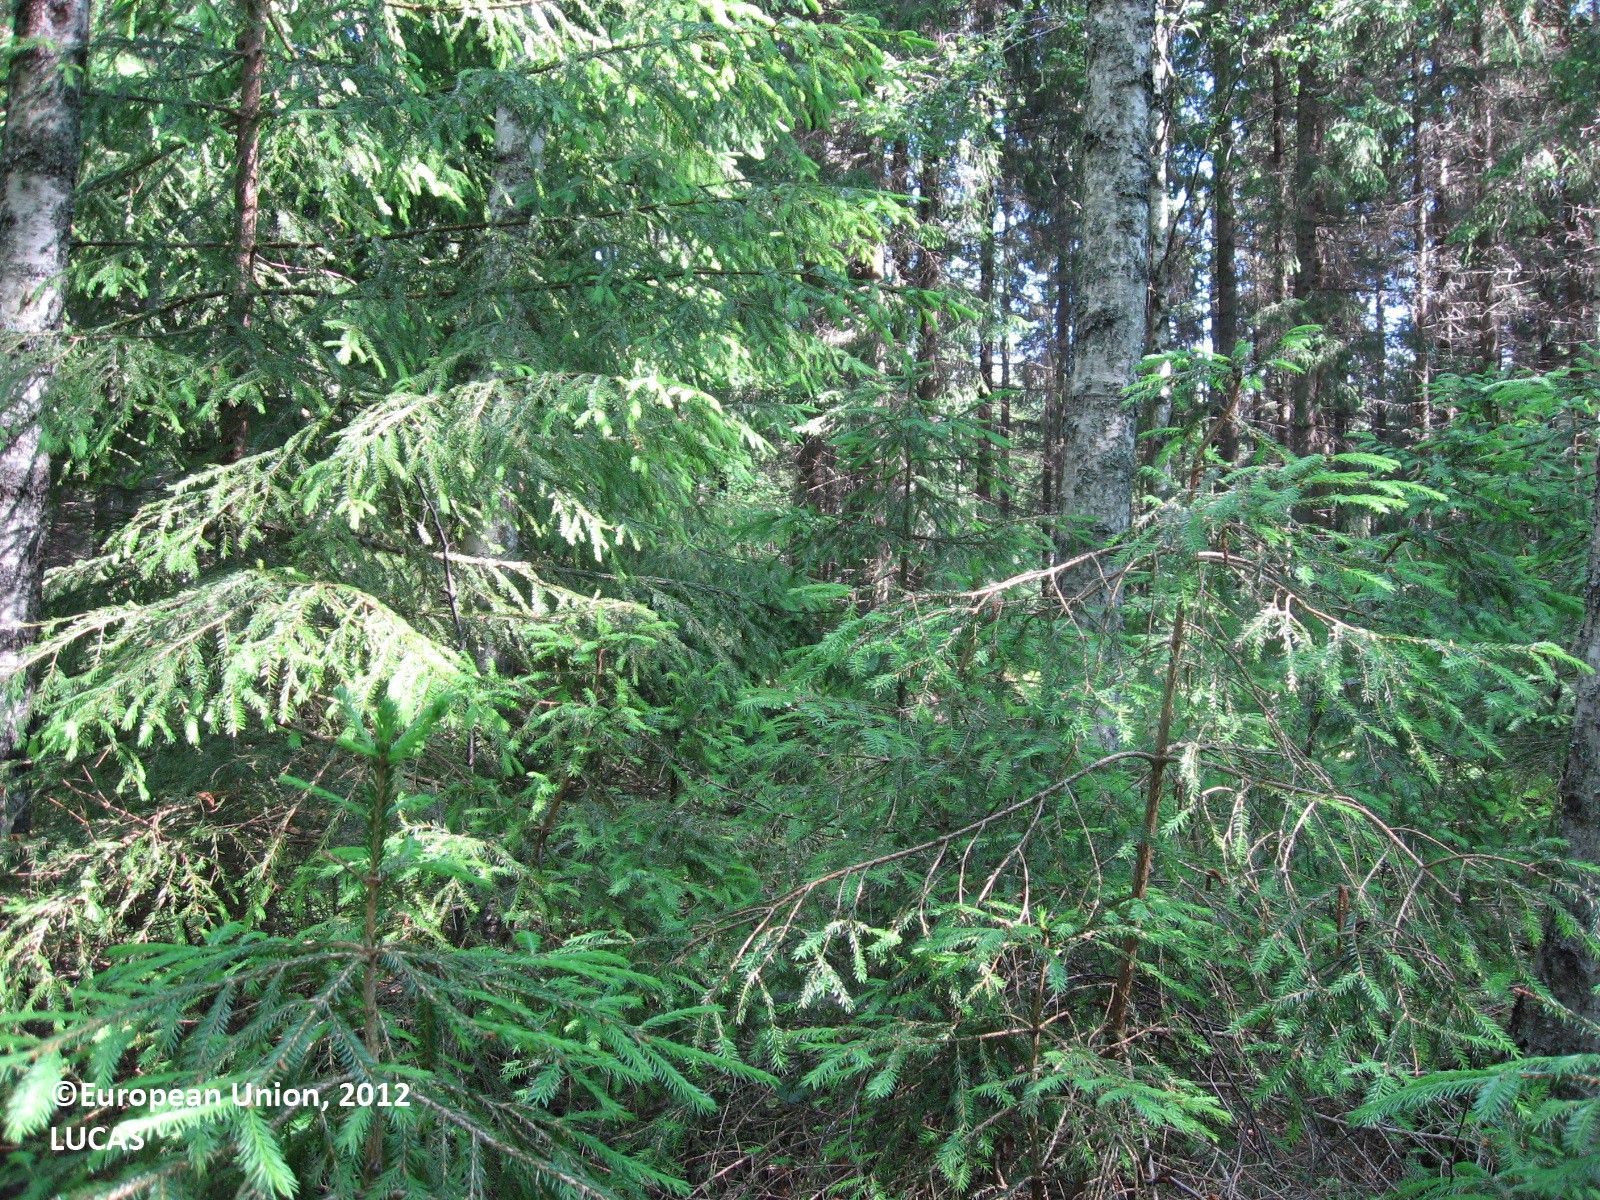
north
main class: Woodland
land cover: Spruce dominated mixed woodland
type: boreal forest
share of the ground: > 75 %
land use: Forestry
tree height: > 5 m
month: June
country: FI
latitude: 60.4618
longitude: 26.4292
